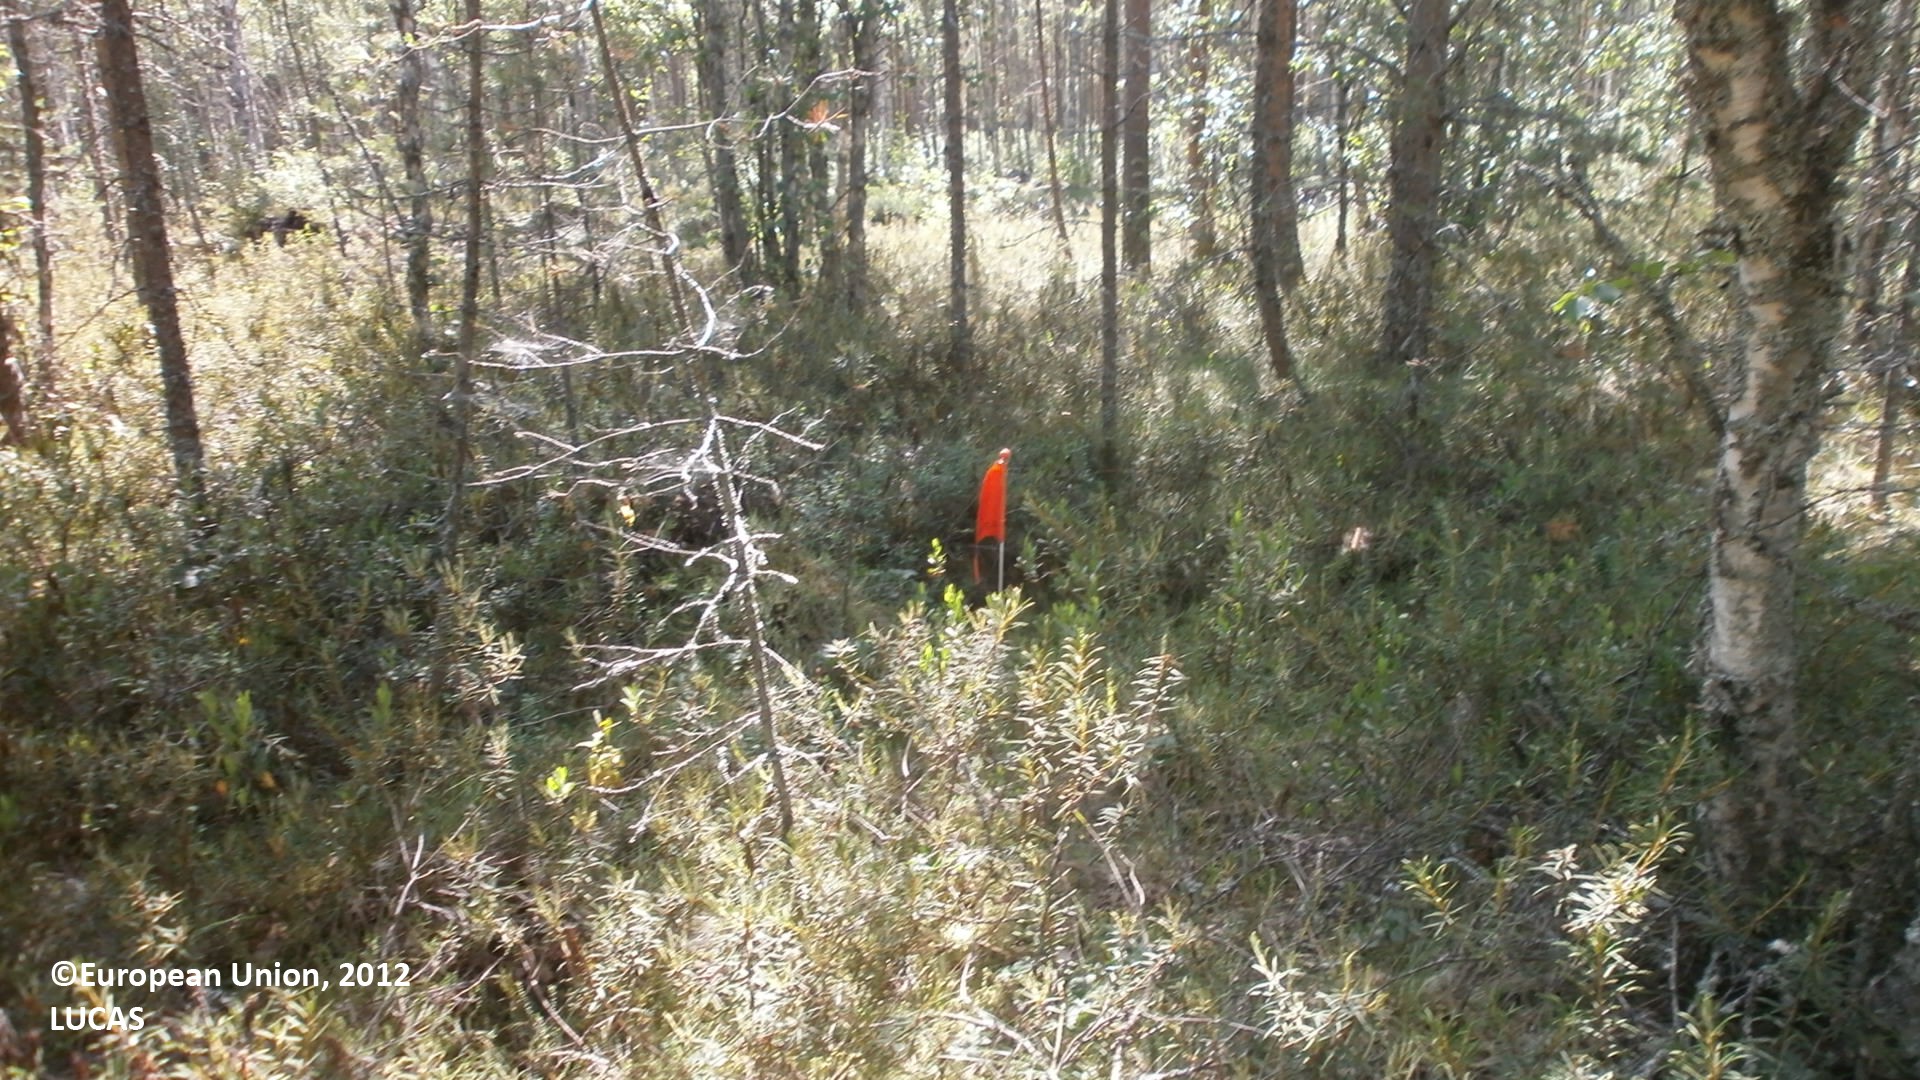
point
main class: Woodland
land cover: Pine dominated mixed woodland
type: mire and swamp forests
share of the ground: 50 - 75 %
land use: Forestry
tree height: > 5 m
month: July
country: FI
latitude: 64.2738
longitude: 24.1681
